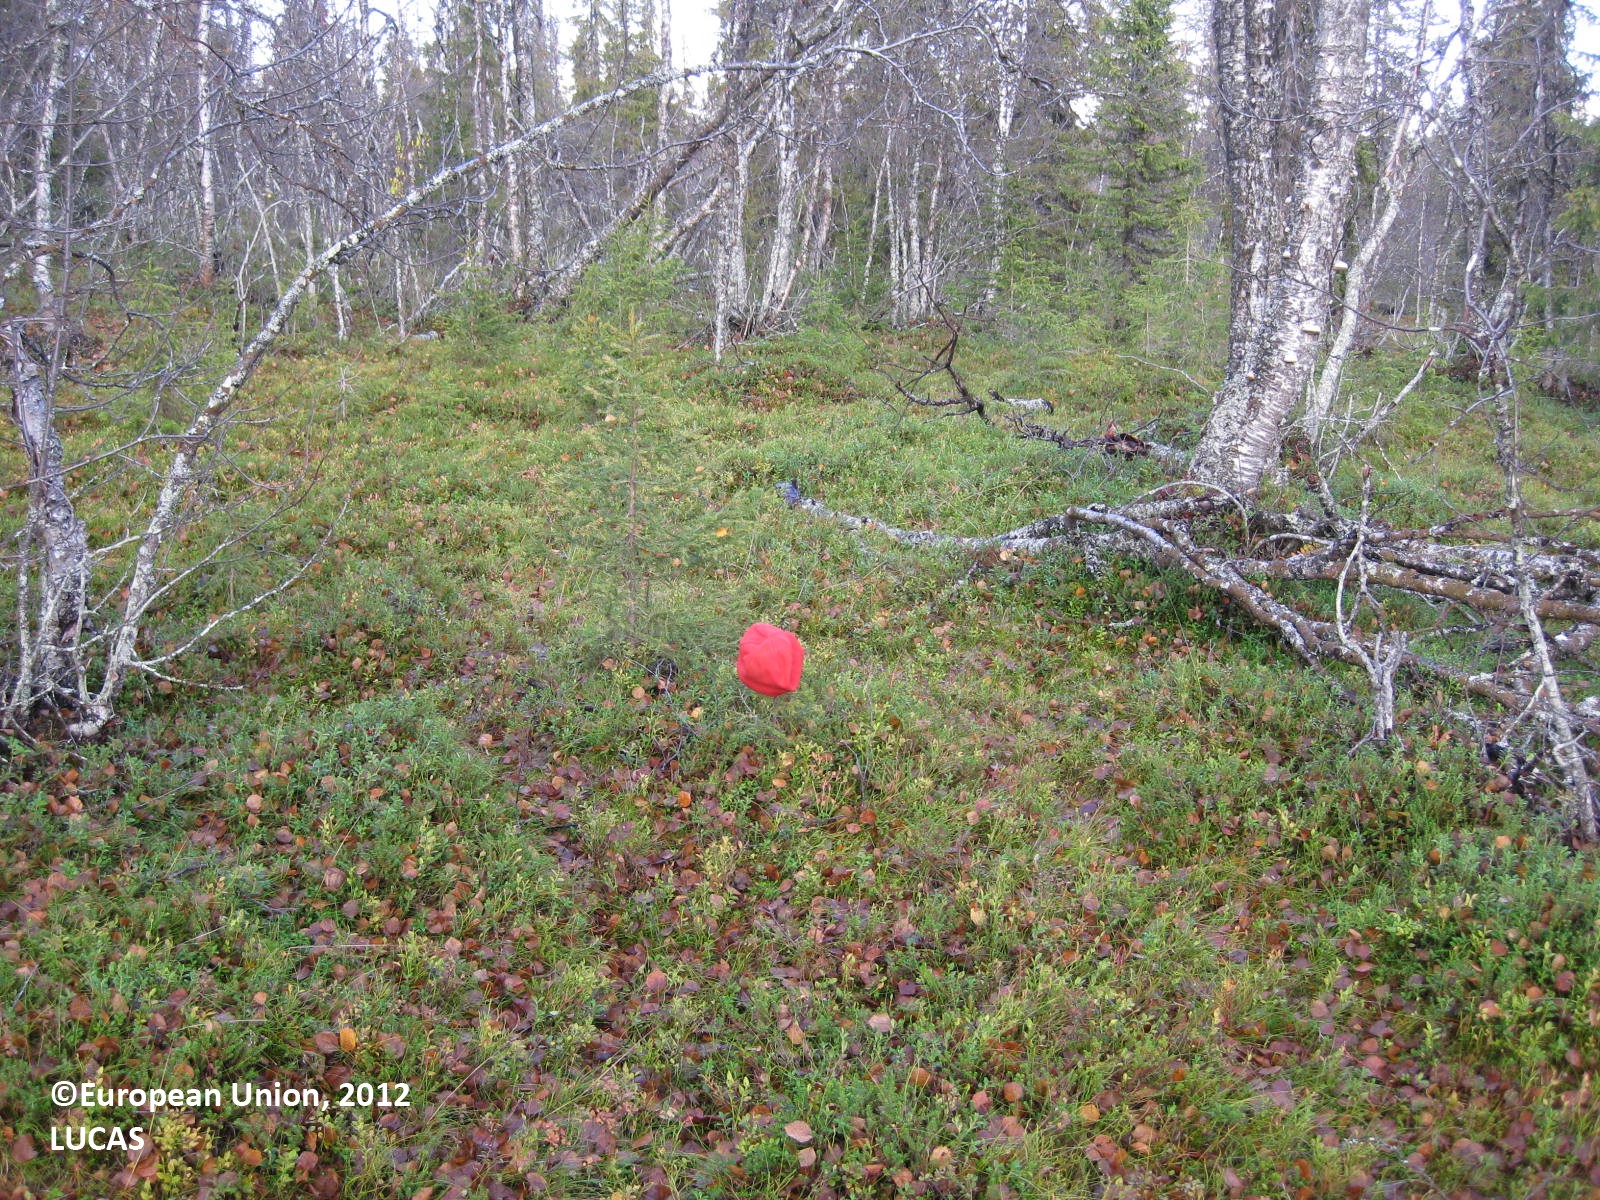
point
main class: Woodland
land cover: Other mixed woodland
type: boreal forest
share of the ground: 50 - 75 %
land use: Forestry
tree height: > 5 m
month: September
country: FI
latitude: 68.2688
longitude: 24.3198
